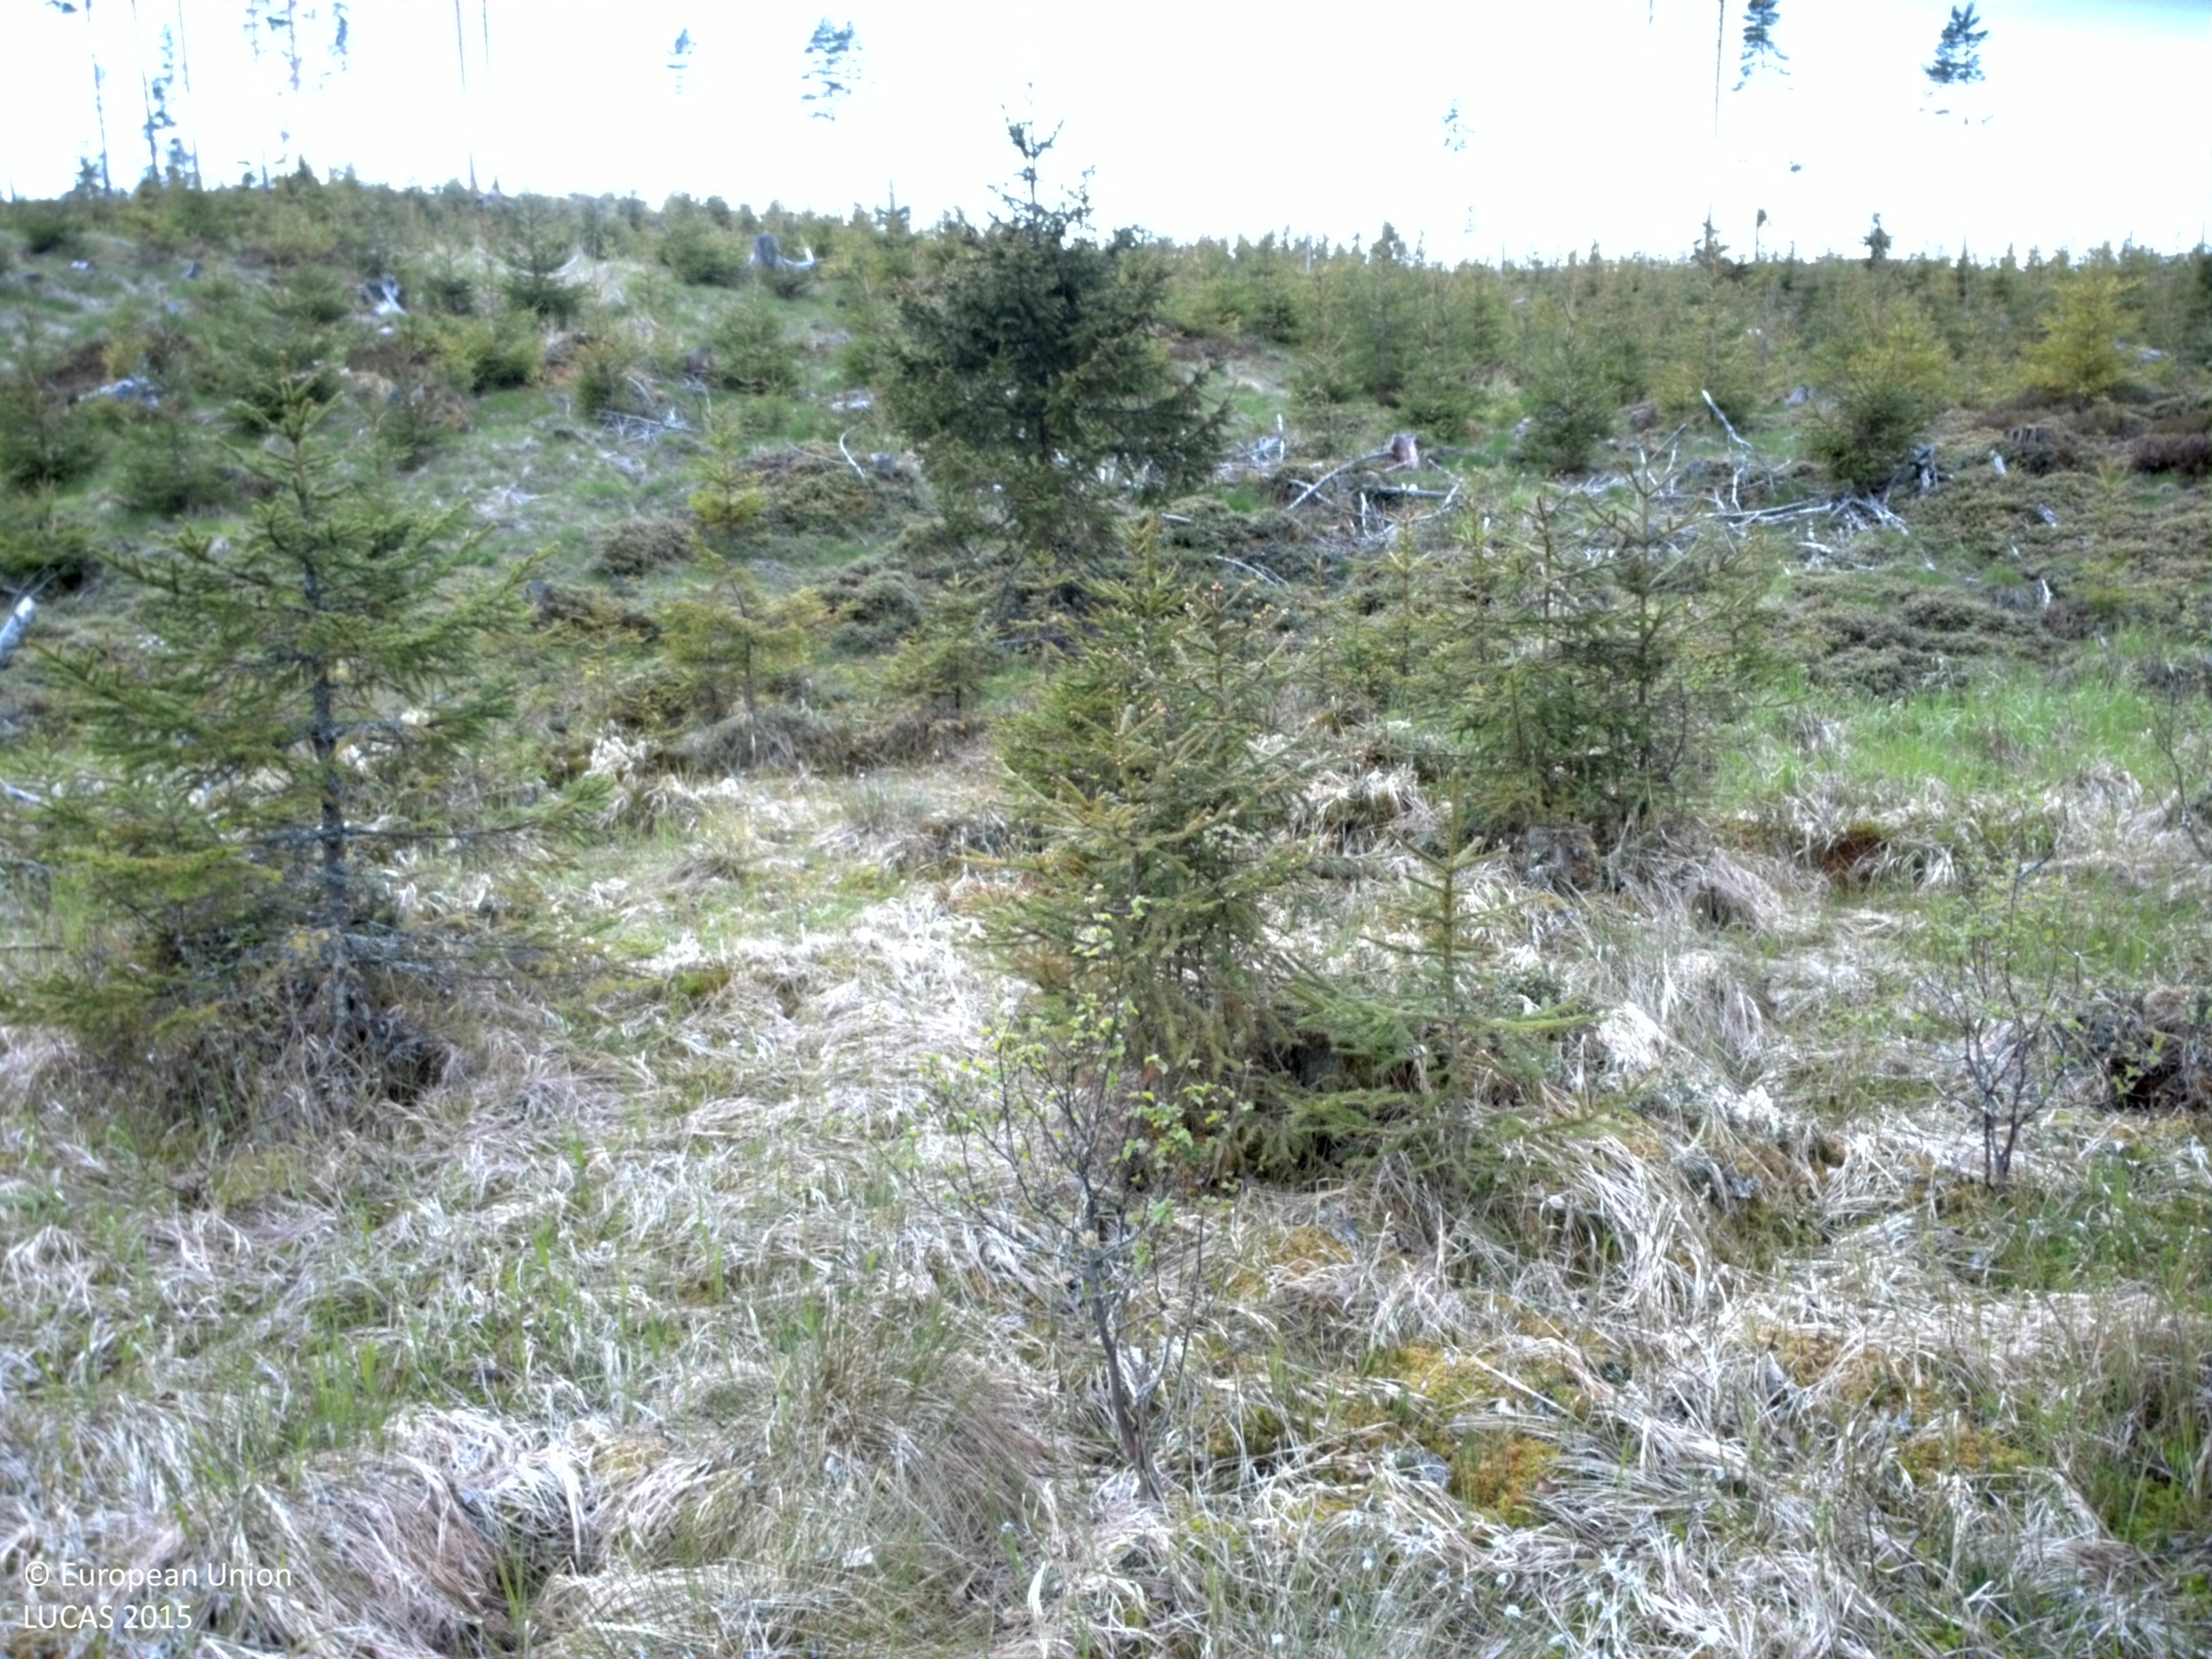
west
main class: Woodland
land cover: Spruce dominated coniferous woodland
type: boreal forest
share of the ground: 10 - 25 %
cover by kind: herbaceous plants 65 %, coniferous forest trees 20 %, shrubs 15 %
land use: Forestry
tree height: < 5 m
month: May
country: SE
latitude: 59.6394
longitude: 12.3174
